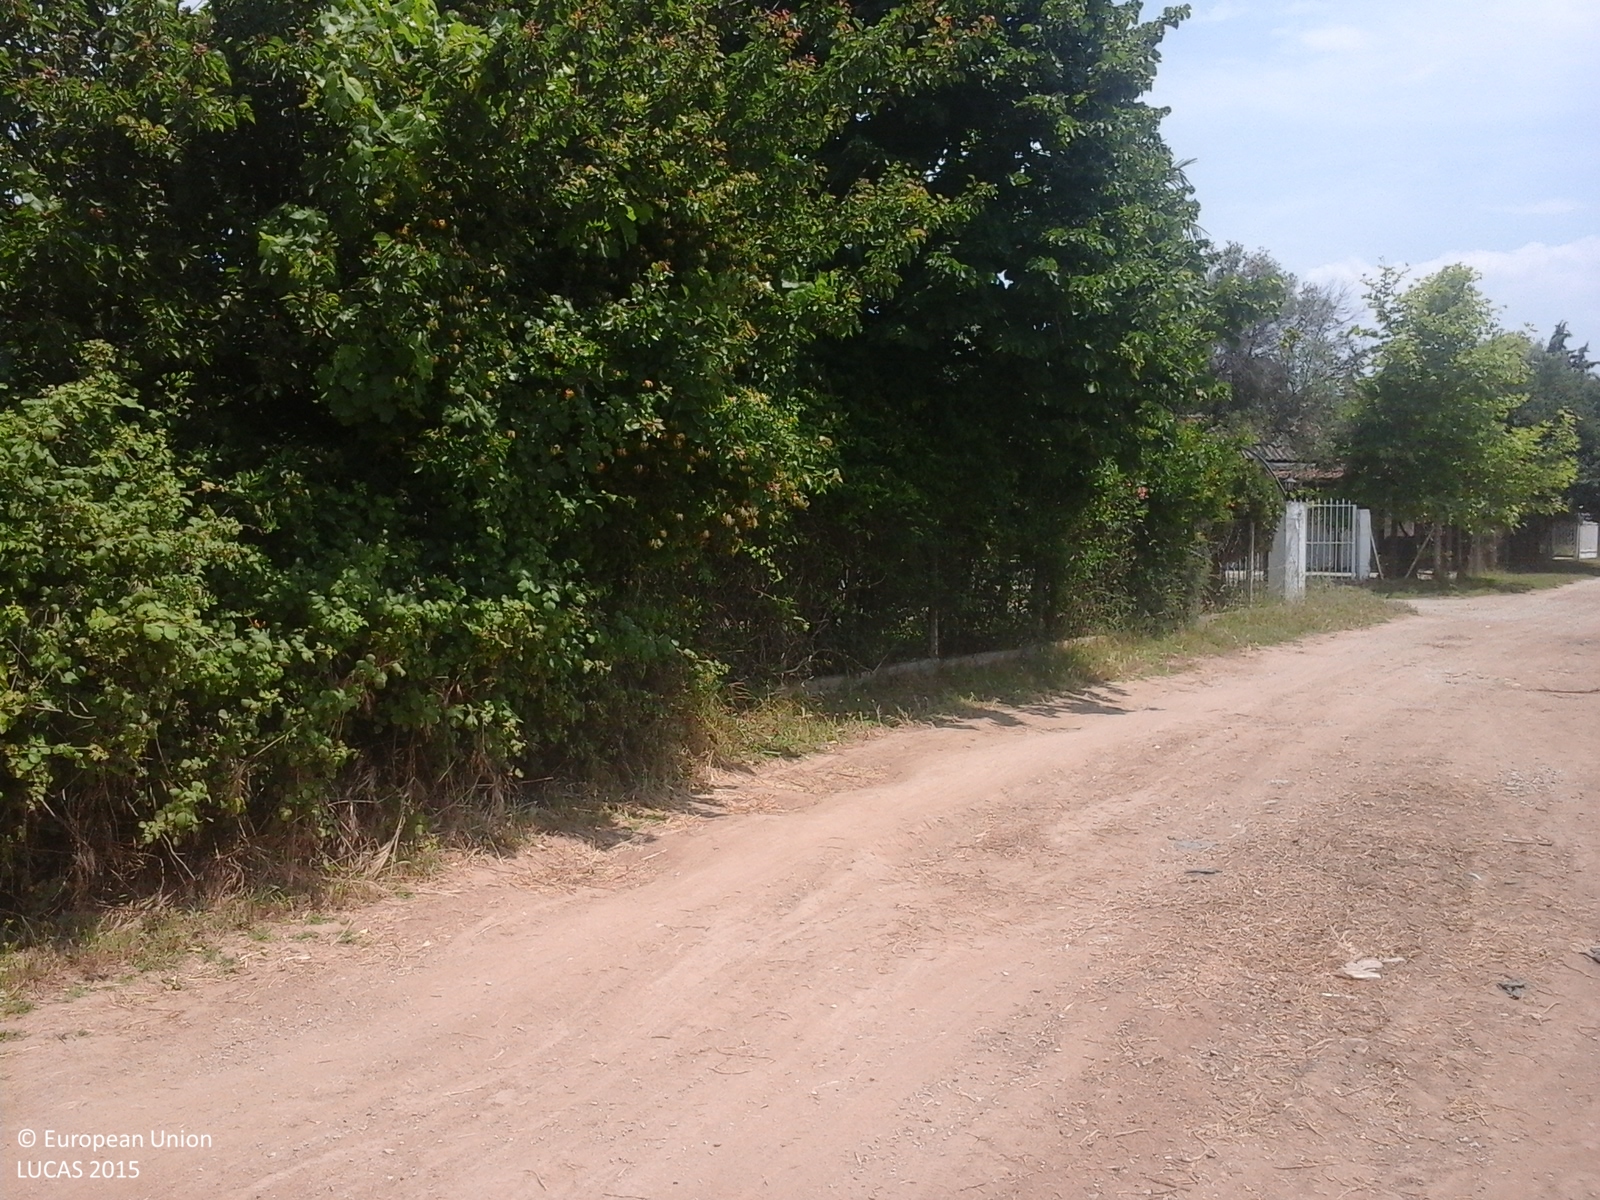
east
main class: Shrubland
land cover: Shrubland with sparse tree cover
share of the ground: > 75 %
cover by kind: shrubs 95 %, broadleaved forest trees 5 %
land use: Semi-natural and natural areas not in use
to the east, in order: Shrubland with sparse tree cover; Artificial constructions in urban areas; Conifer hedges; Olive groves; Broadleaved woodland; Other bare soil; Single bushes/trees; Electric lines; Paved roads, cycling and walking lanes; Spontaneously vegetated surfaces; Artificial constructions in urban areas
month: June
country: GR
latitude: 40.4407
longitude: 22.8662
